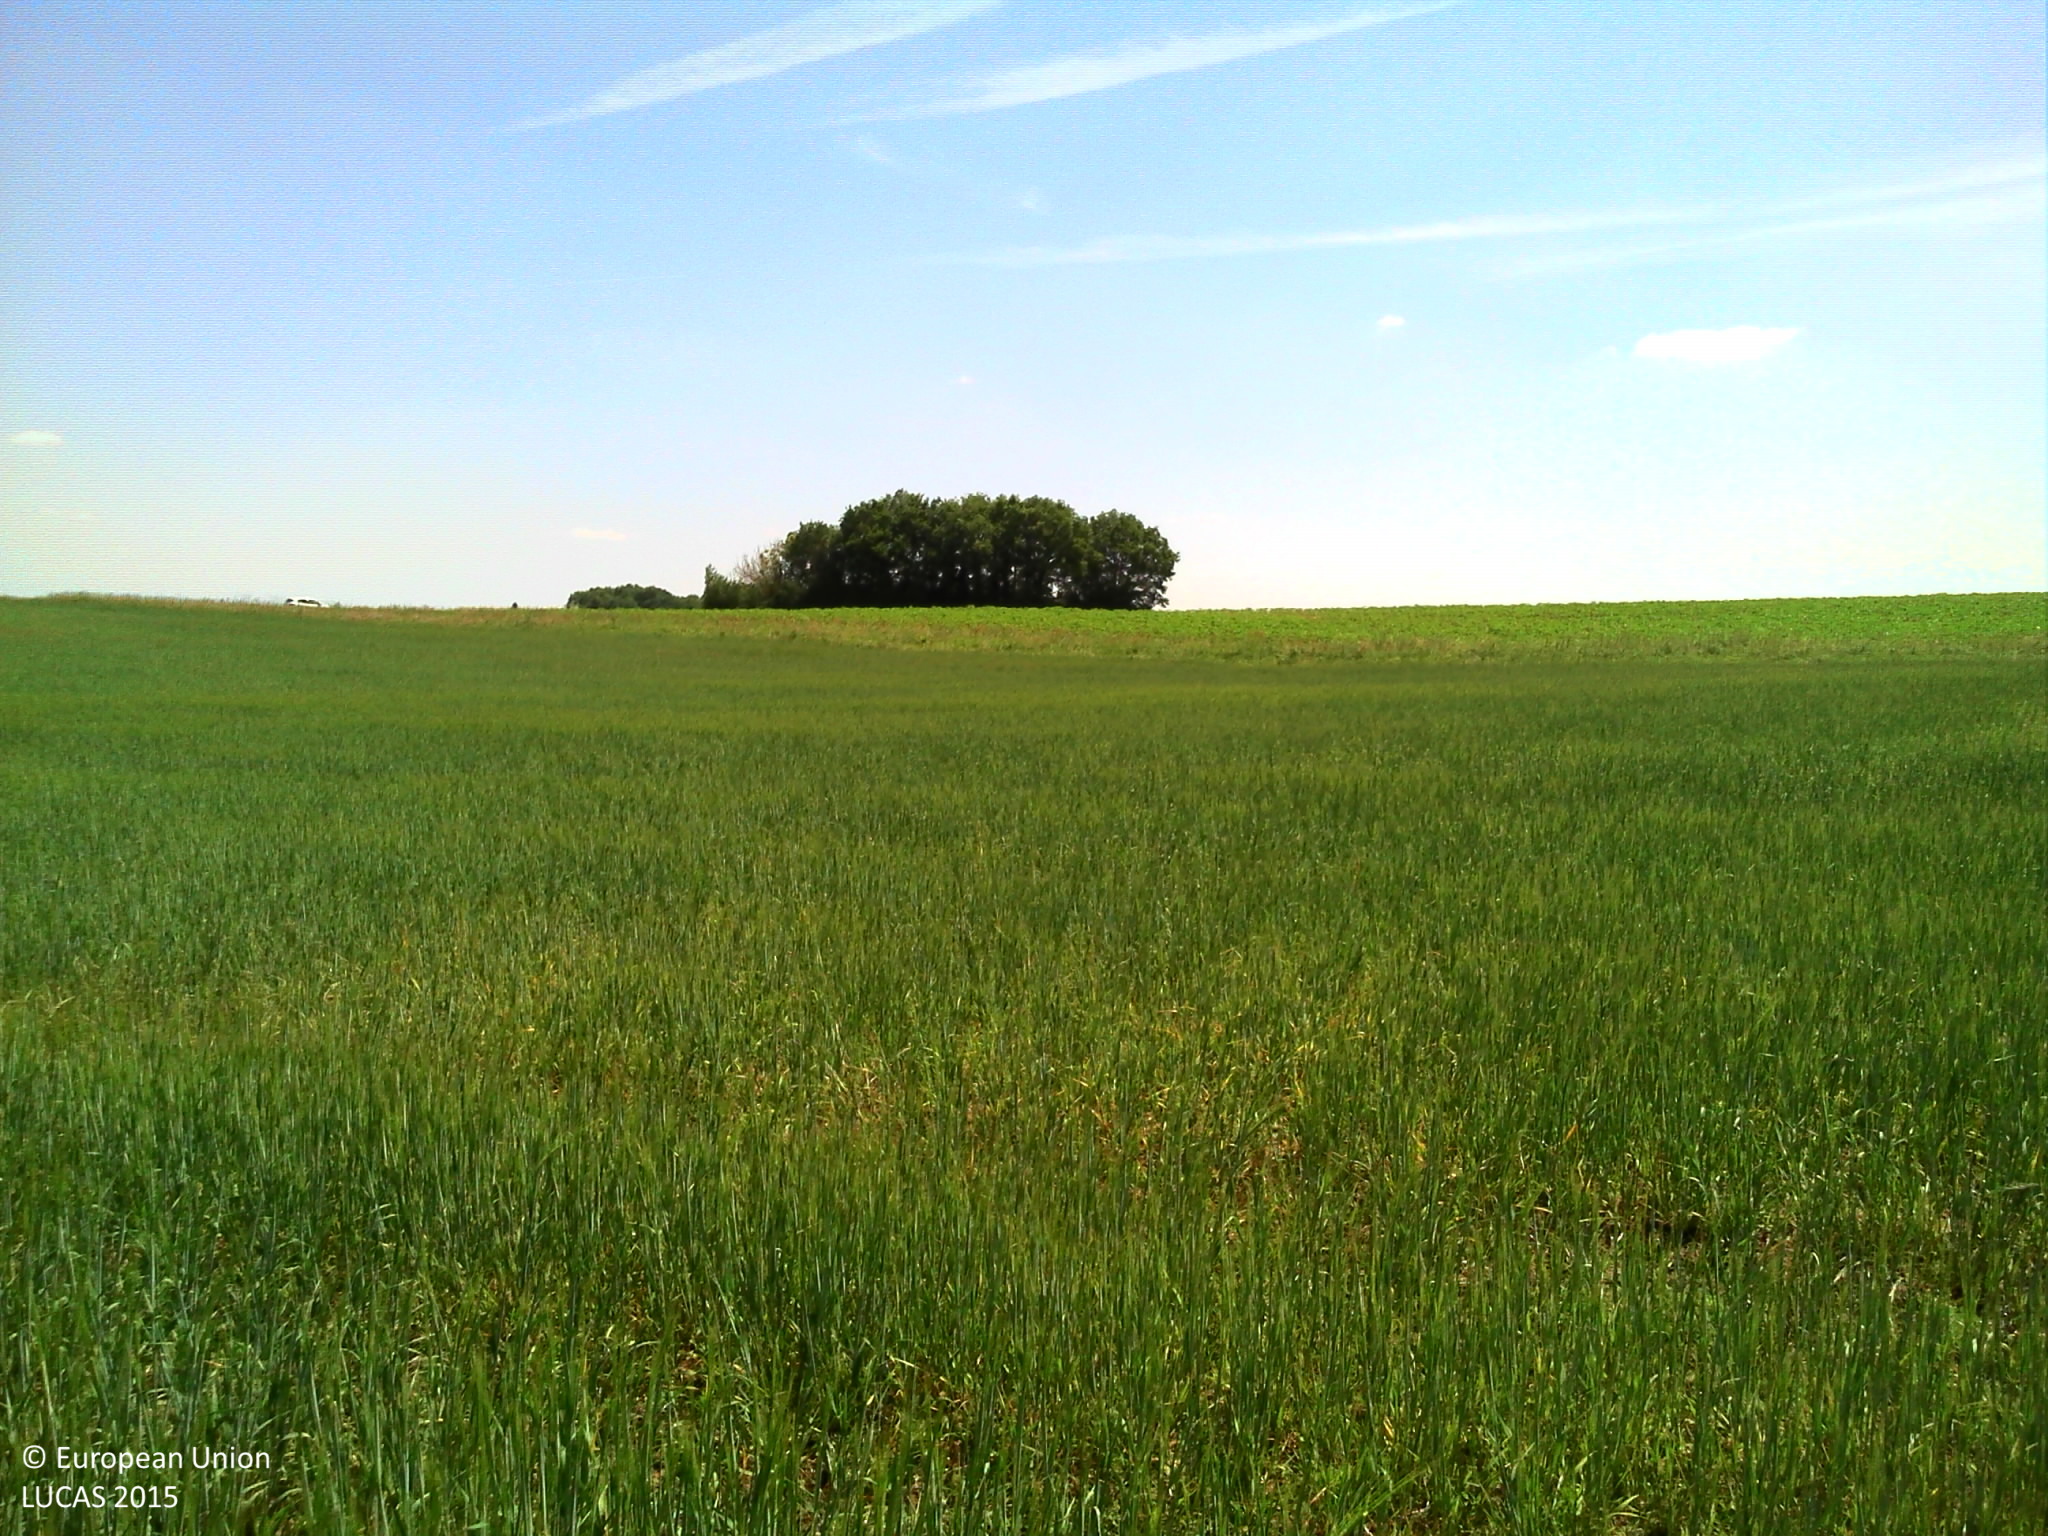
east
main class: Cropland
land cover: Barley
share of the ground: > 75 %
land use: Agriculture (excluding fallow land and kitchen gardens)
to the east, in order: Barley; Grass margins; Tracks; Grass margins; Ditches and canals; Grass margins; Sunflower; Grass margins; Ditches and canals; Grass margins; Tracks; Grass margins; Sunflower
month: June
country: FR
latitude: 46.5175
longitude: 0.6116
